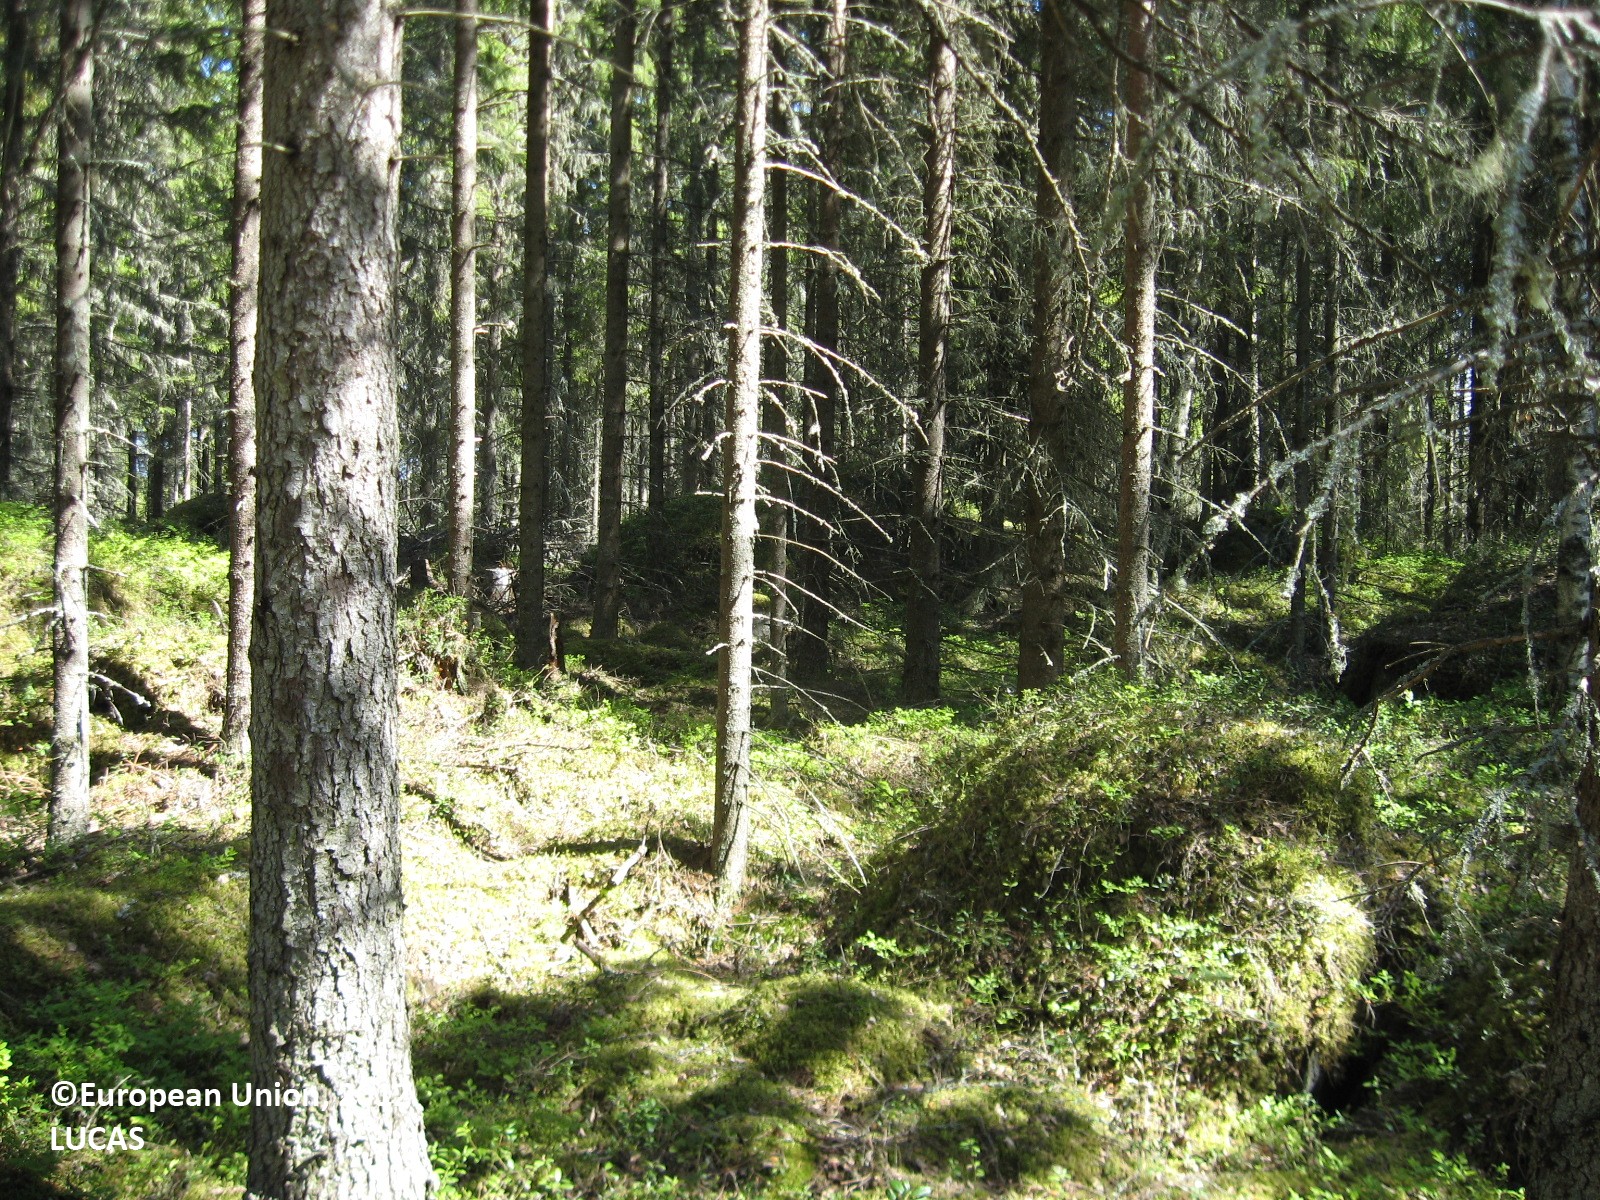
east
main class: Woodland
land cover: Spruce dominated coniferous woodland
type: boreal forest
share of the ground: > 75 %
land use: Forestry
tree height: > 5 m
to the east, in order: Spruce dominated coniferous woodland; Inland water bodies
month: June
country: FI
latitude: 63.2573
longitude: 21.8534
